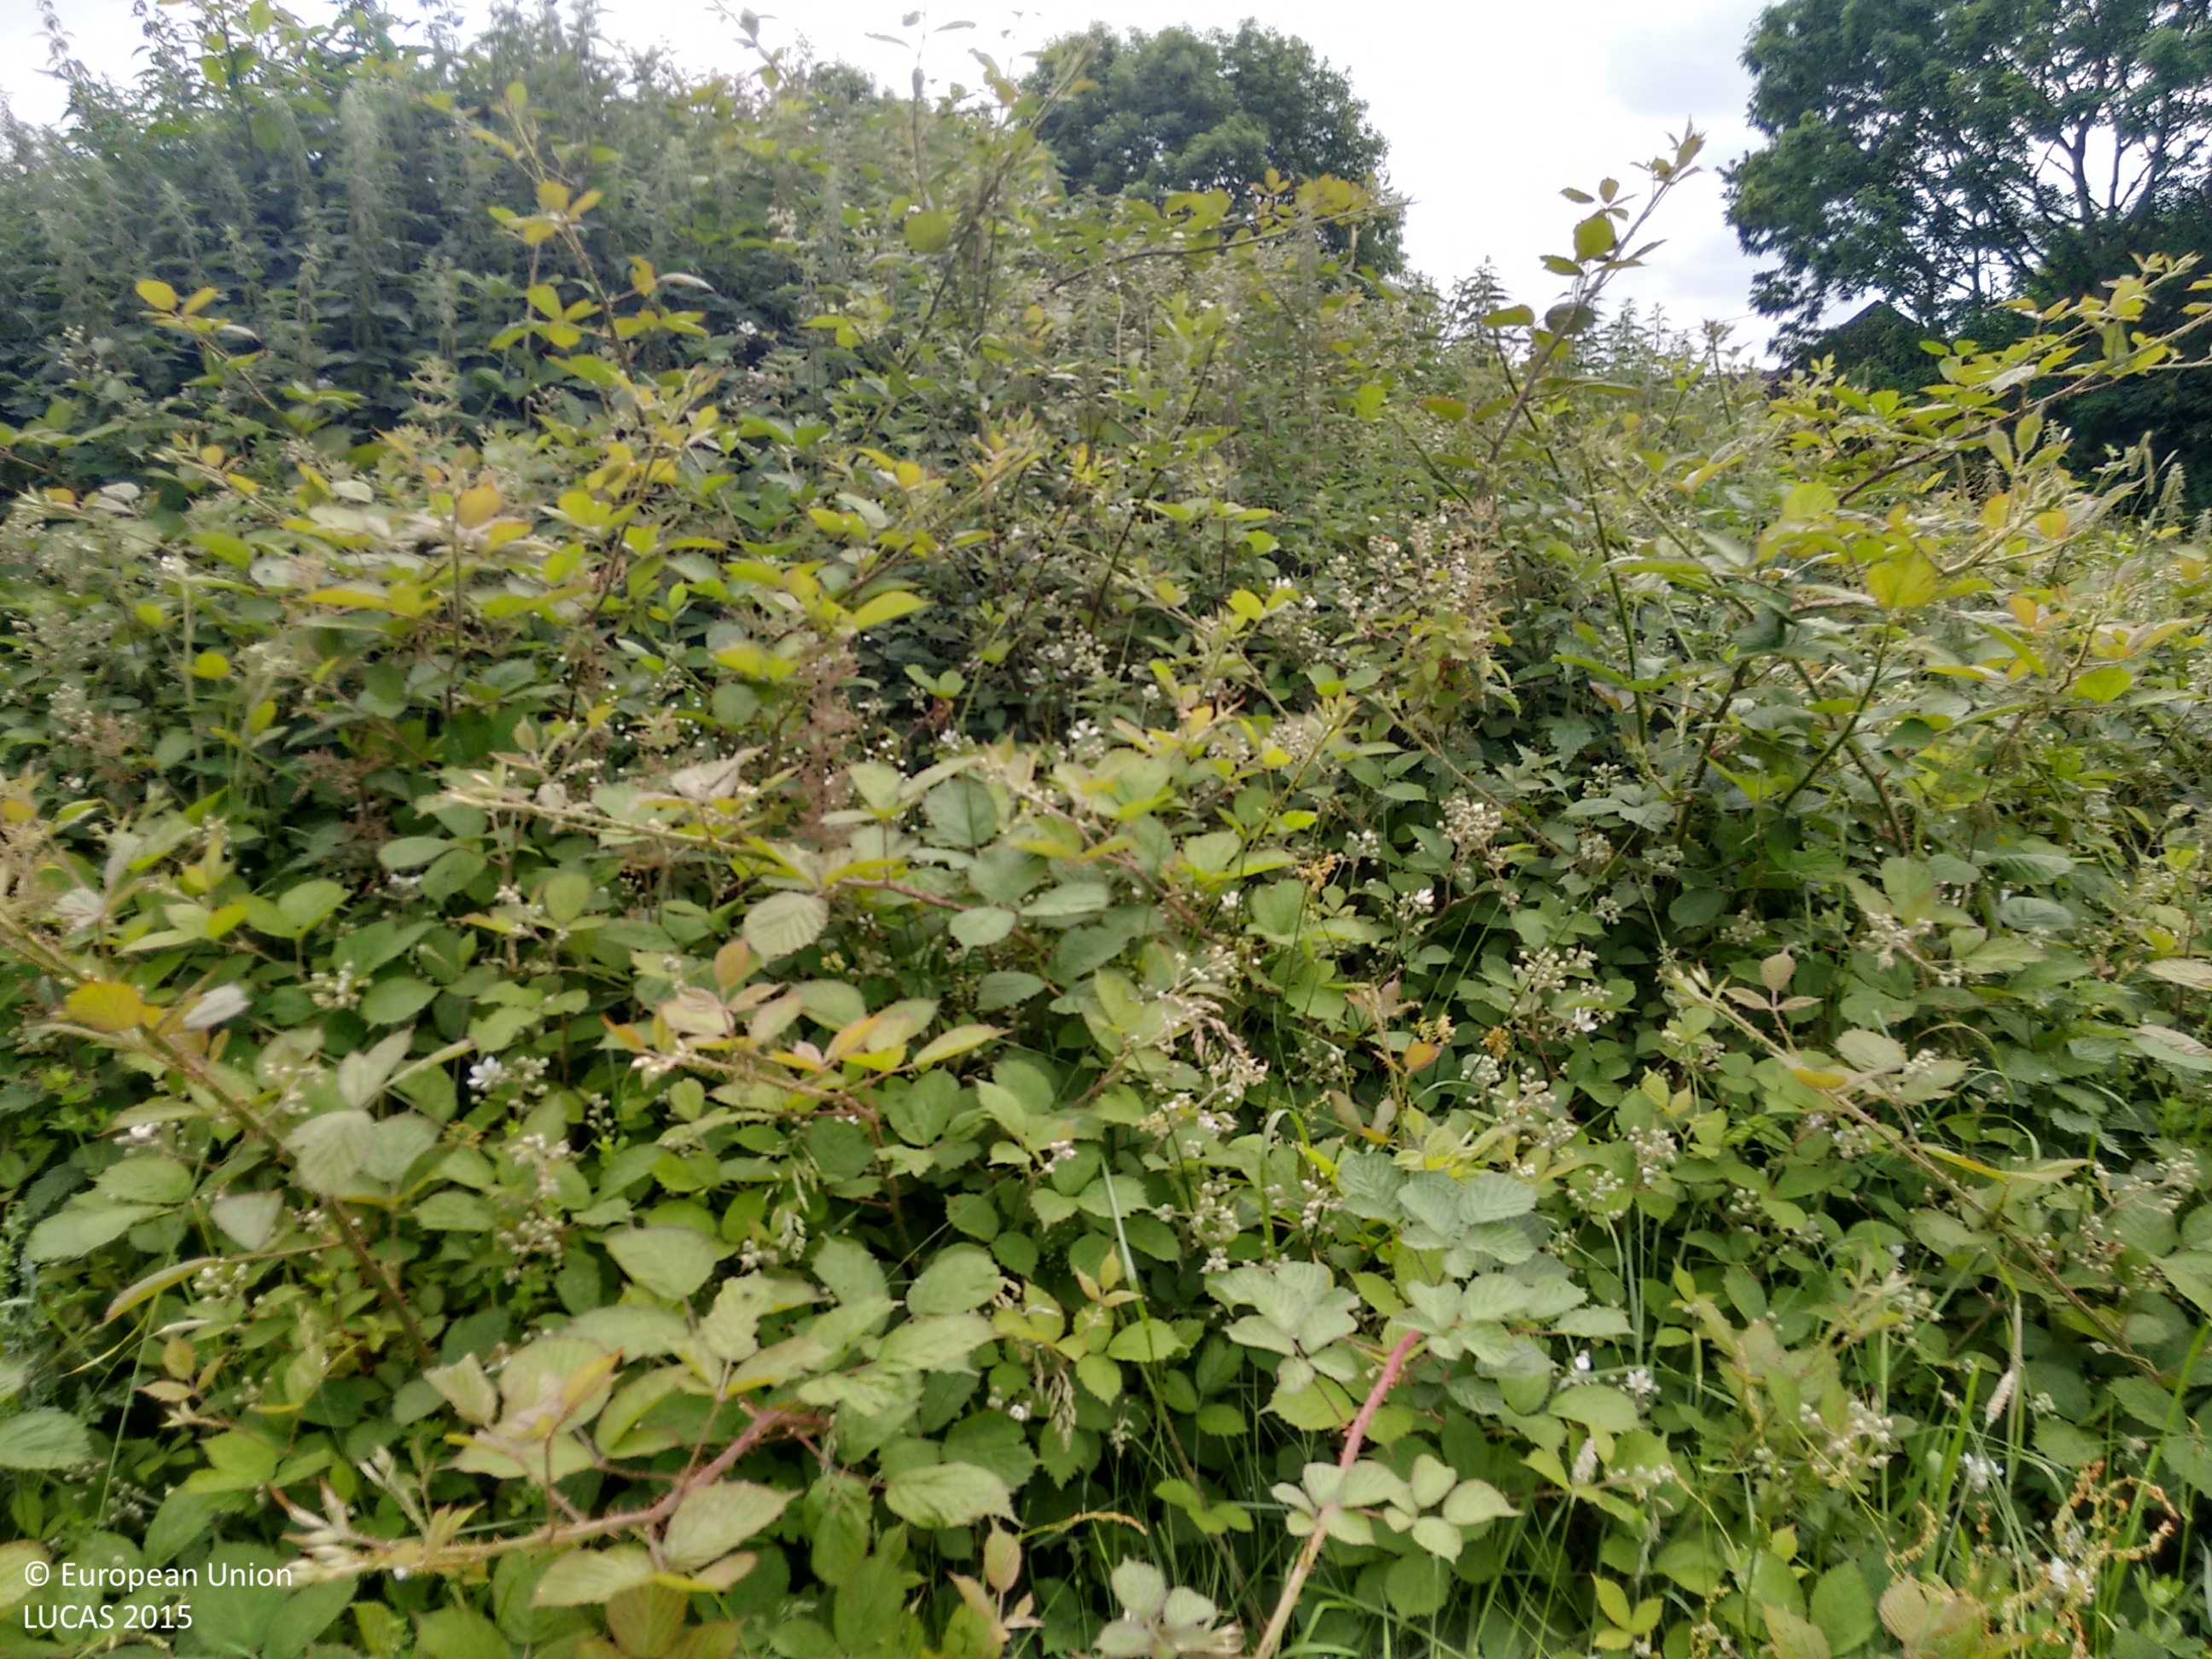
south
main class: Grassland
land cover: Grassland without tree/shrub cover
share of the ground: > 75 %
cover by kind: herbaceous plants 95 %, shrubs 5 %
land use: Agriculture (excluding fallow land and kitchen gardens)
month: July
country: IE
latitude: 52.2559
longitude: -8.2479
